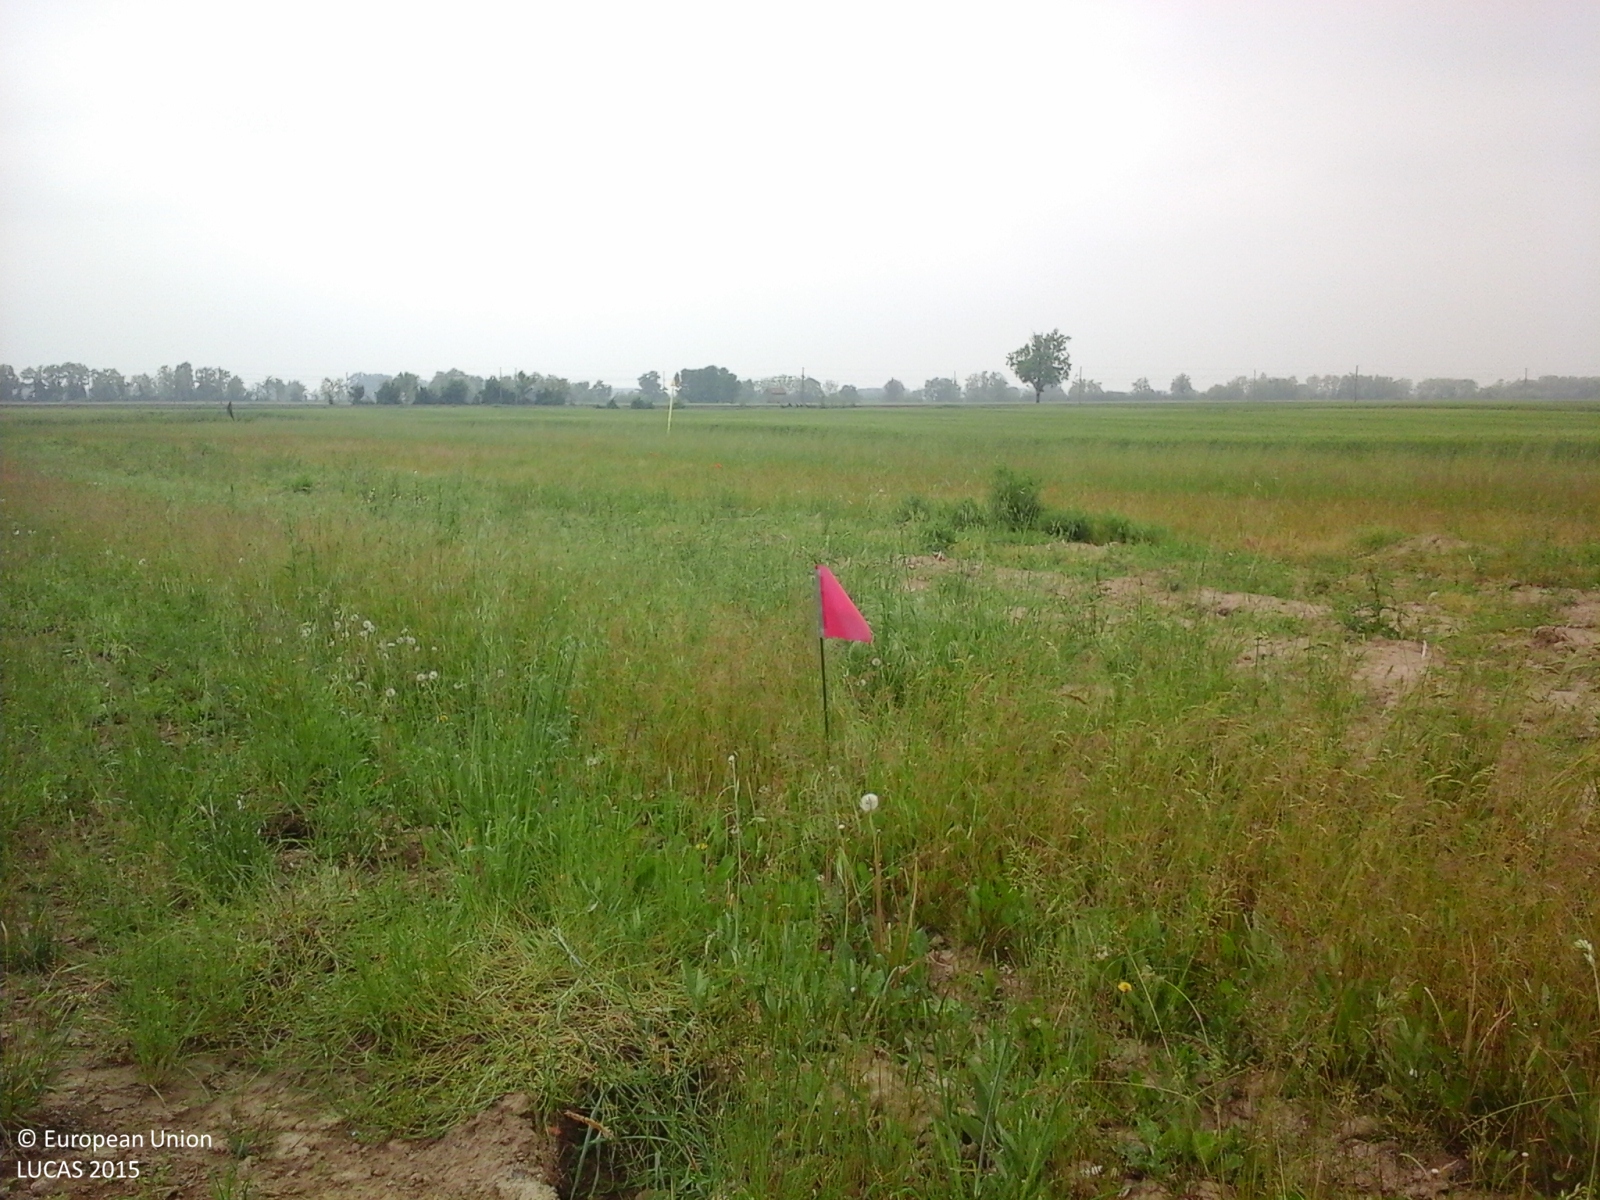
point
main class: Grassland
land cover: Spontaneously vegetated surfaces
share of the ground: > 75 %
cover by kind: herbaceous plants 100 %
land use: Fallow land
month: May
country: IT
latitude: 45.1252
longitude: 10.3934
